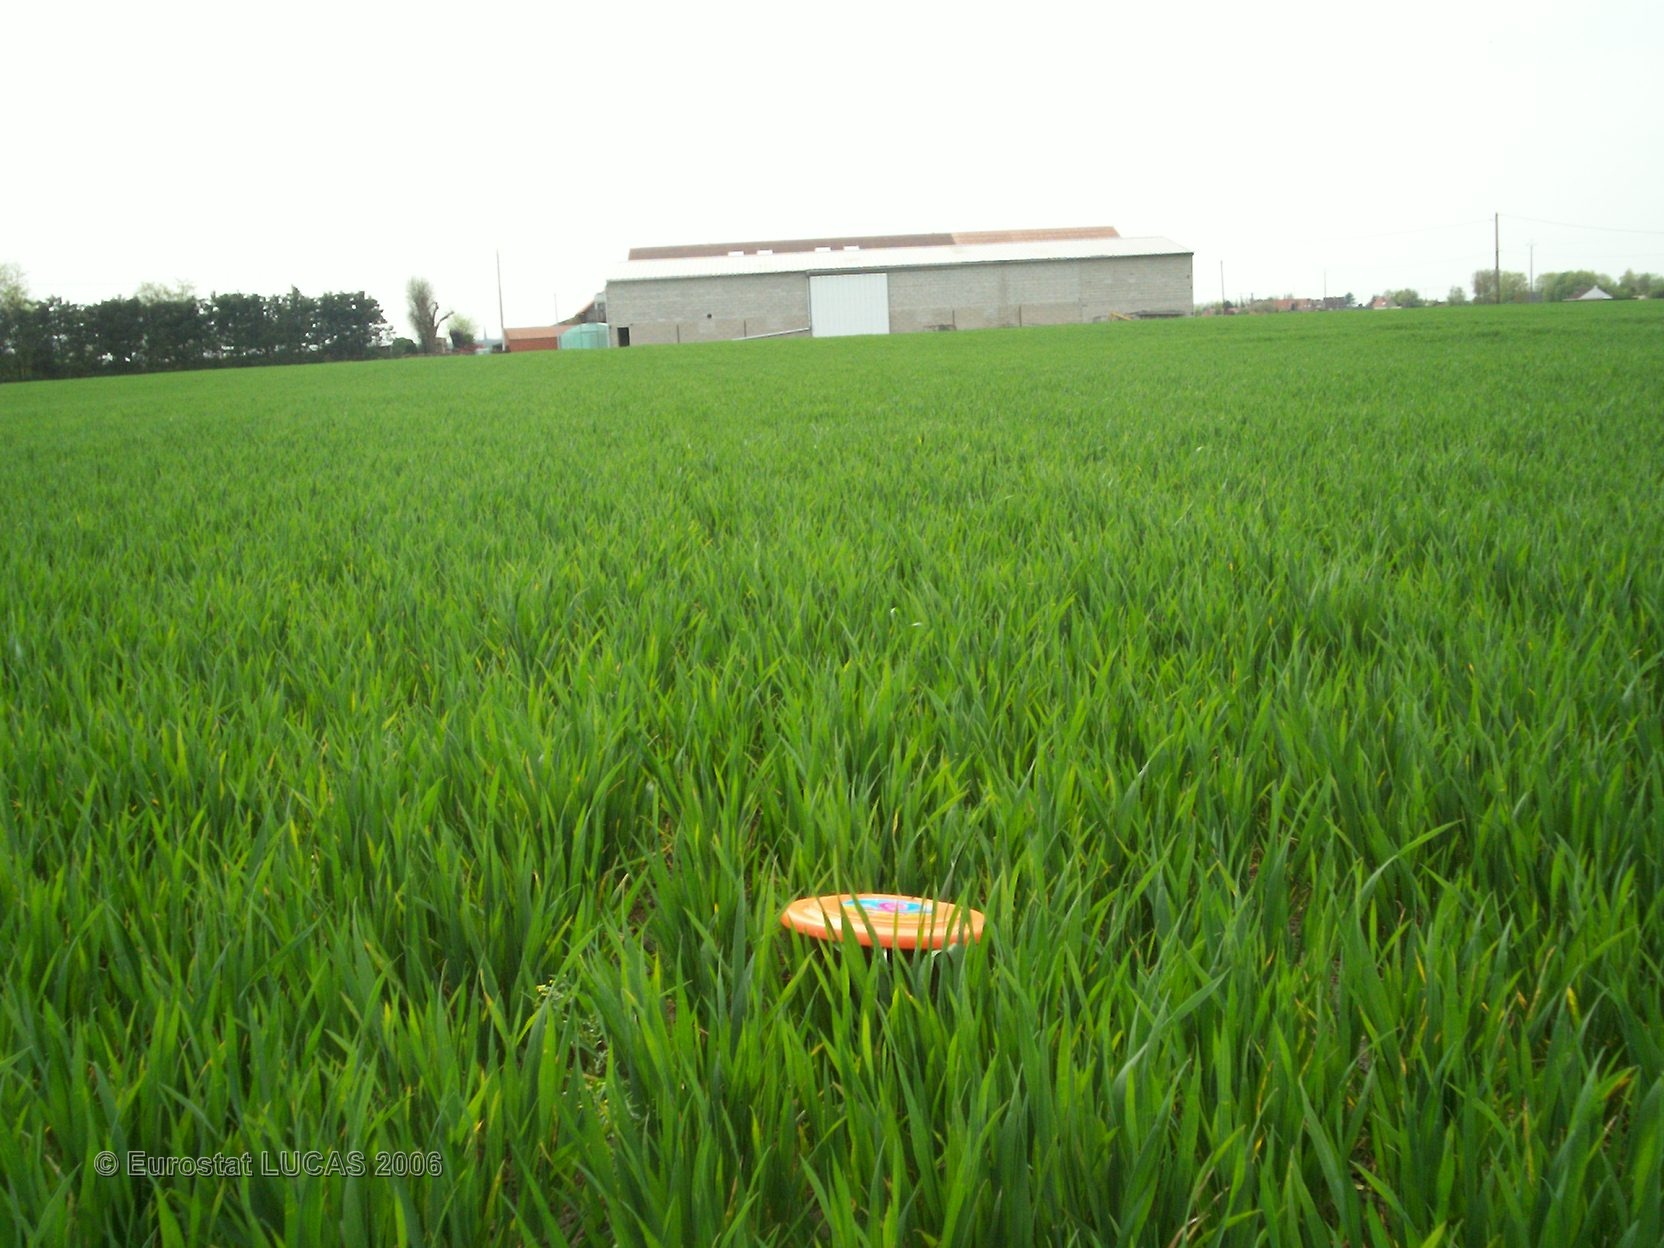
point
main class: Cropland
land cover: Common wheat
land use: Agriculture (excluding fallow land and kitchen gardens)
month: May
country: FR
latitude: 50.9832
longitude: 2.4802
